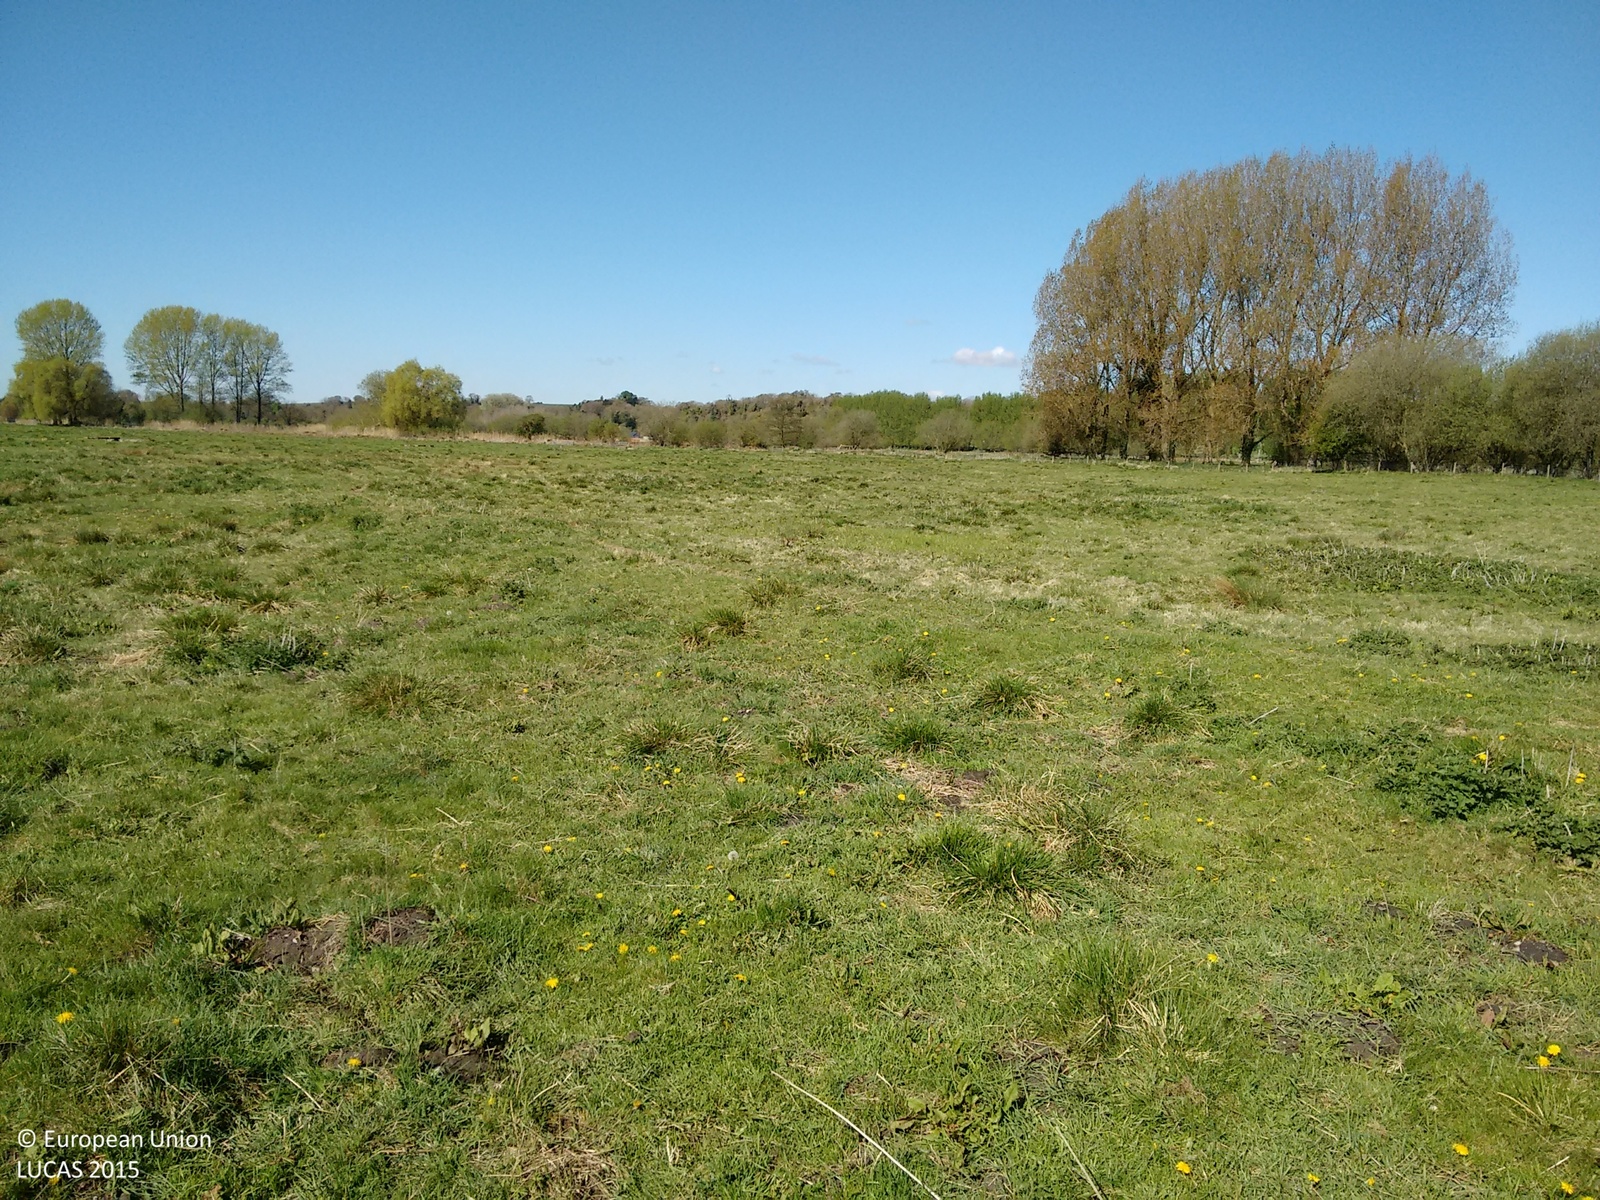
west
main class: Grassland
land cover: Grassland without tree/shrub cover
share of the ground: > 75 %
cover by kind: herbaceous plants 100 %
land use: Agriculture (excluding fallow land and kitchen gardens)
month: April
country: GB
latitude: 51.1704
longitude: -1.4203
